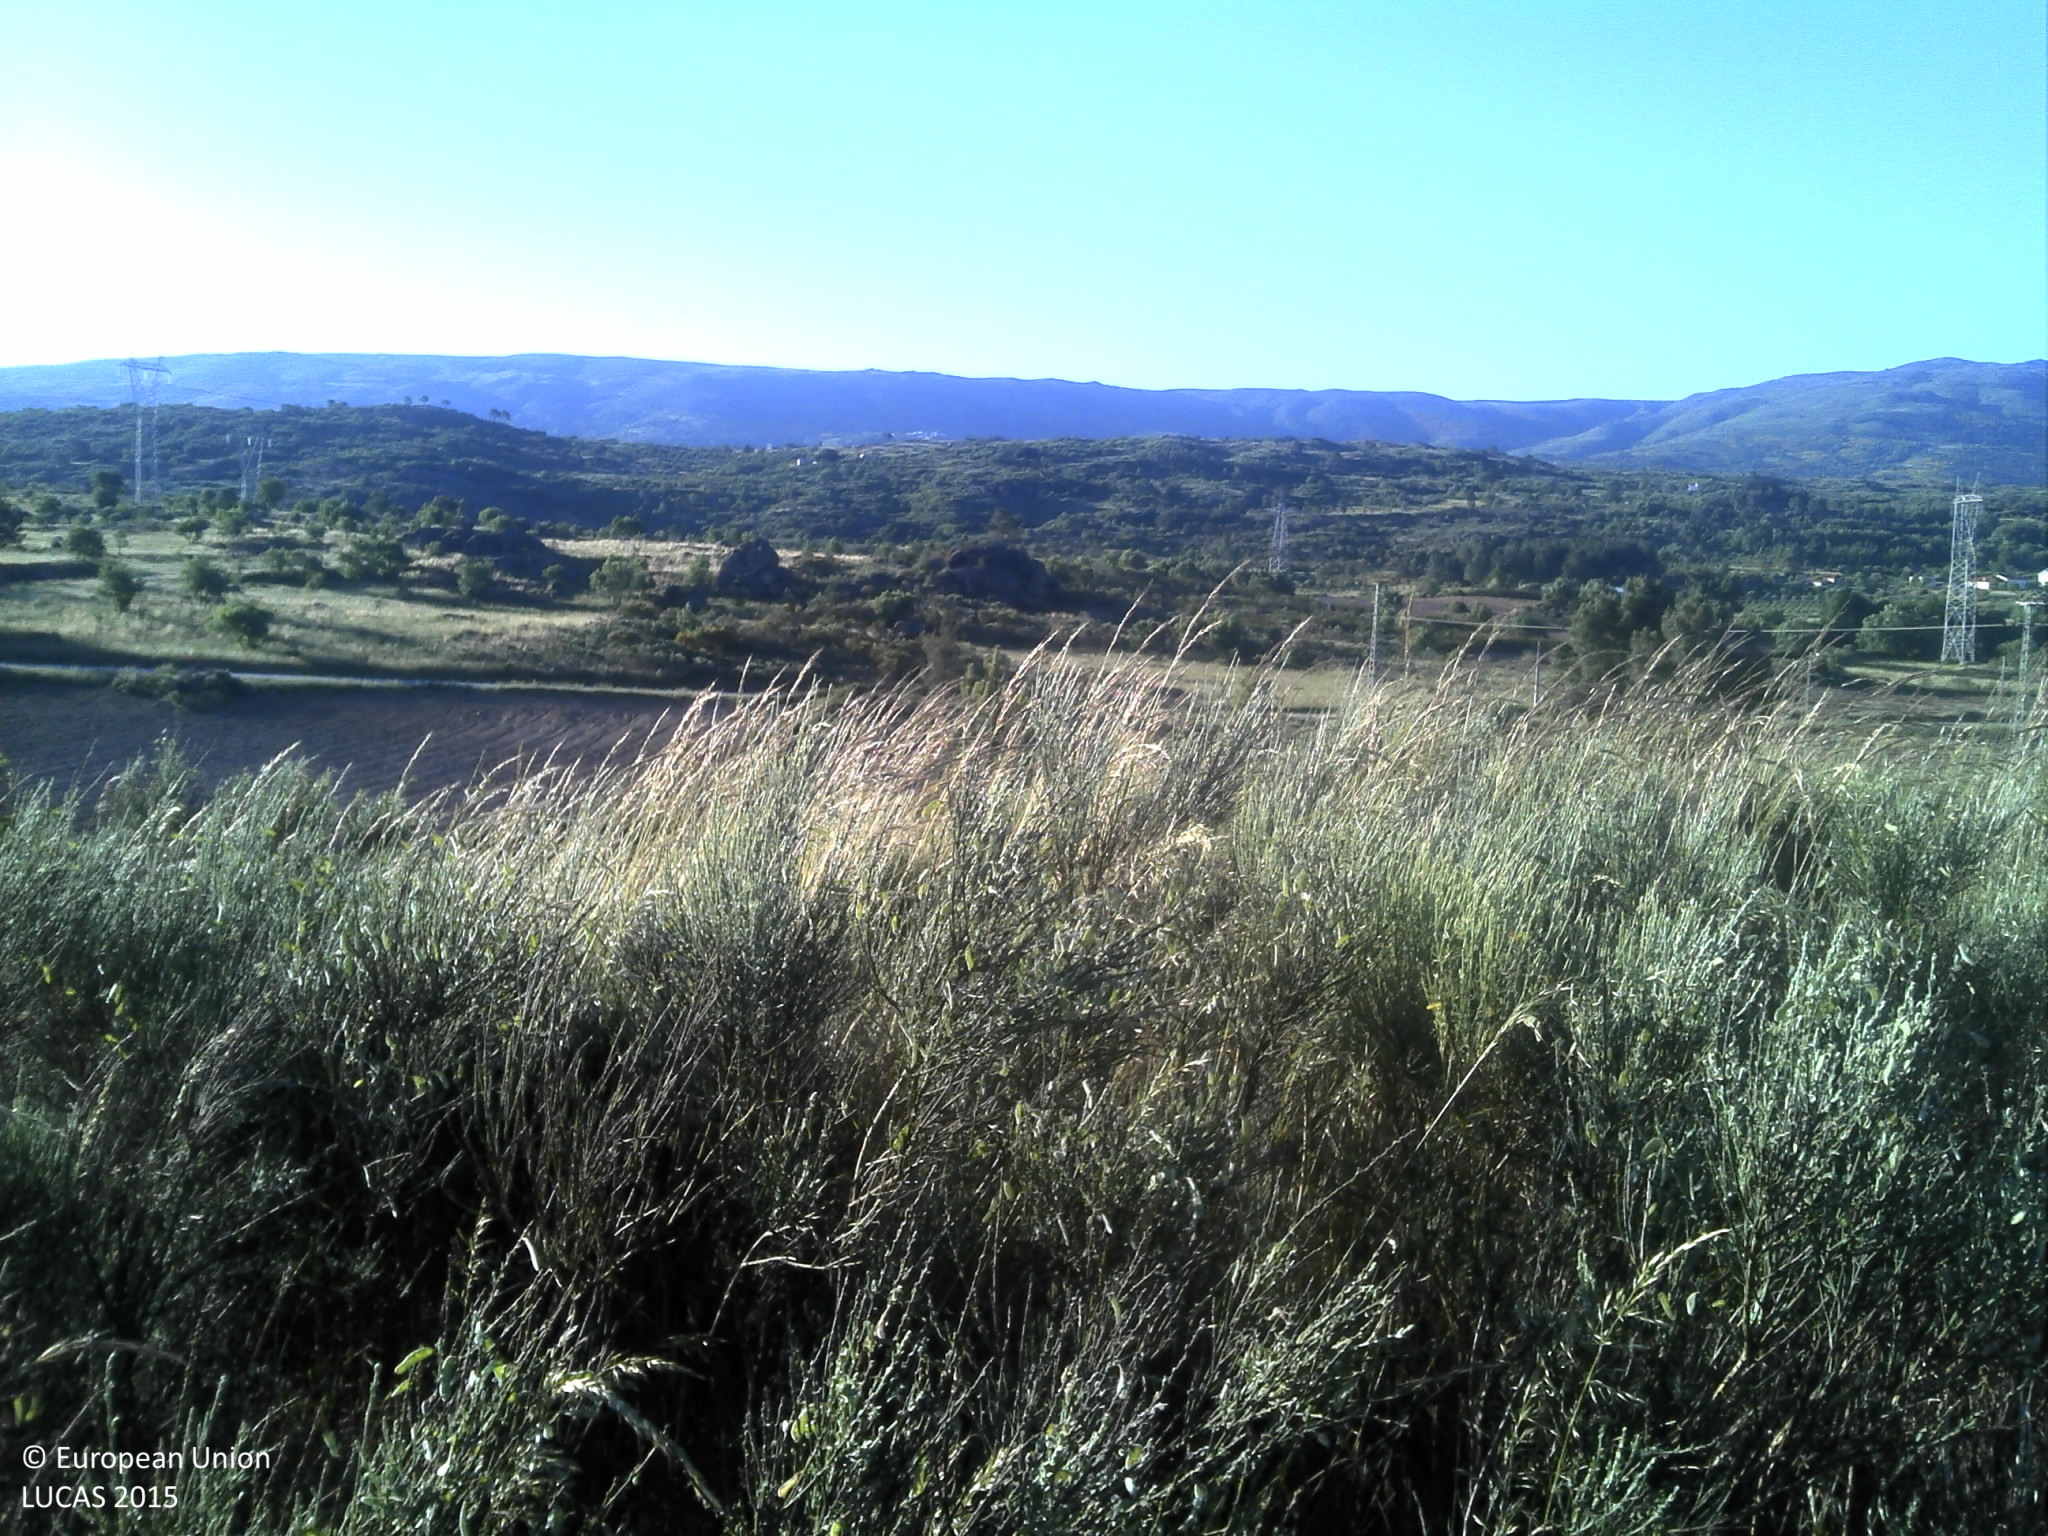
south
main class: Shrubland
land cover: Shrubland without tree cover
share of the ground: 50 - 75 %
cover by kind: shrubs 70 %, herbaceous plants 10 %, unconsolidated bare surface 10 %
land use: Agriculture (excluding fallow land and kitchen gardens)
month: May
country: PT
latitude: 40.5790
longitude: -7.5142
